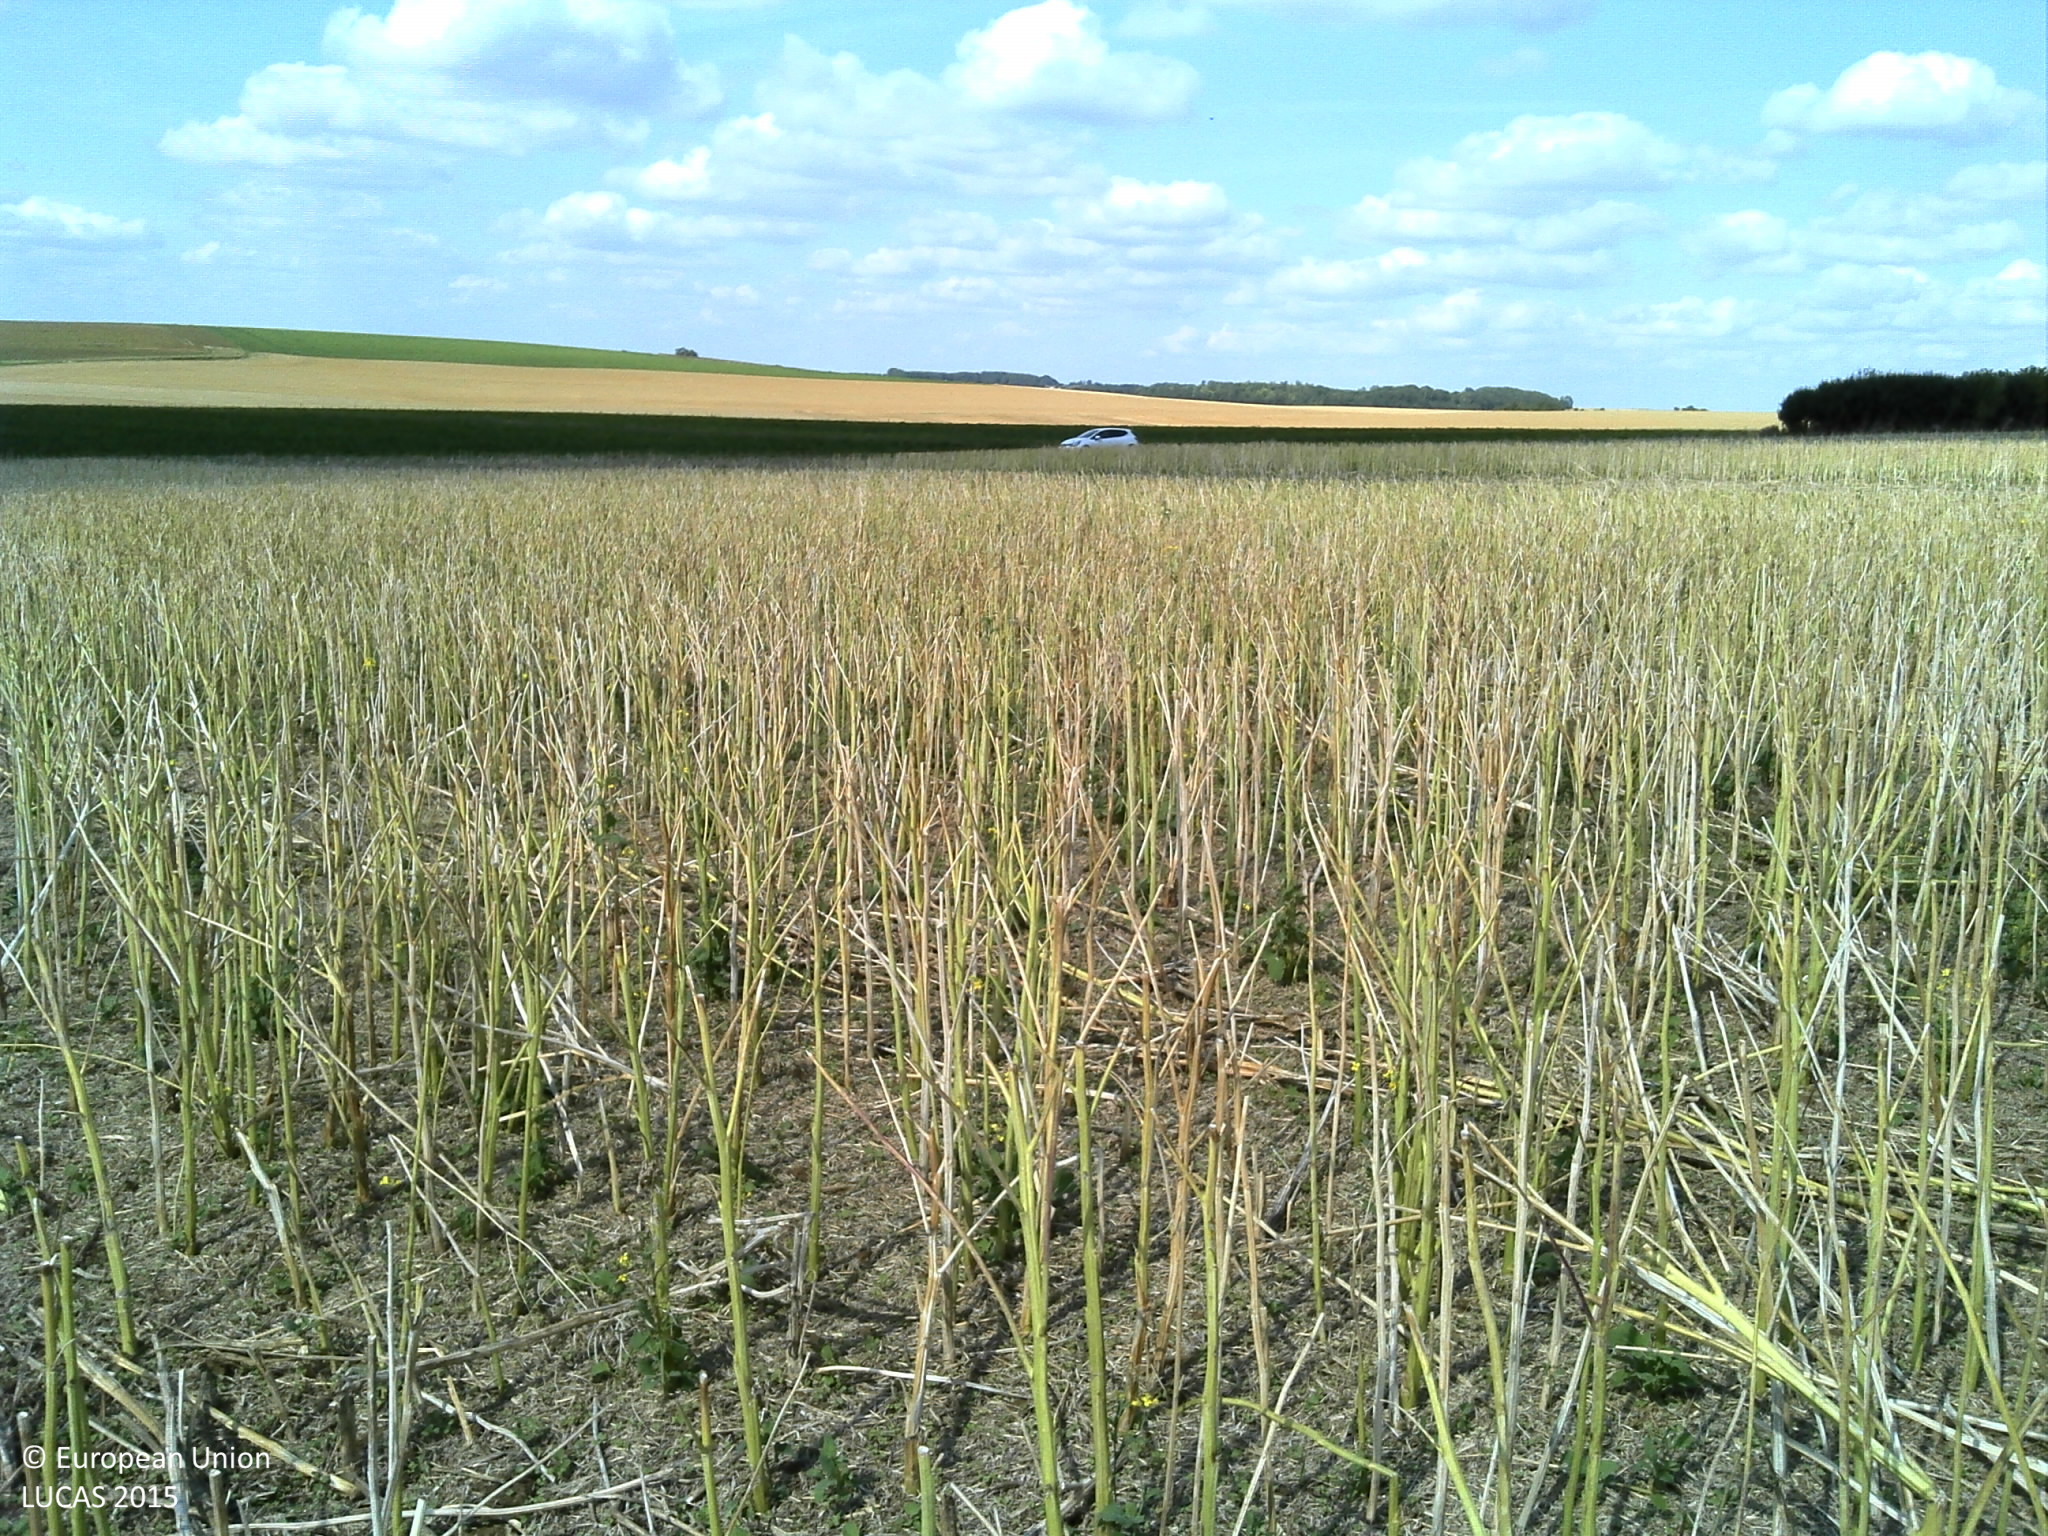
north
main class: Cropland
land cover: Rape and turnip rape
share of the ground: 10 - 25 %
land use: Agriculture (excluding fallow land and kitchen gardens)
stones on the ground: < 10 %
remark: Harvested field
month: August
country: FR
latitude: 49.9420
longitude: 3.1492
